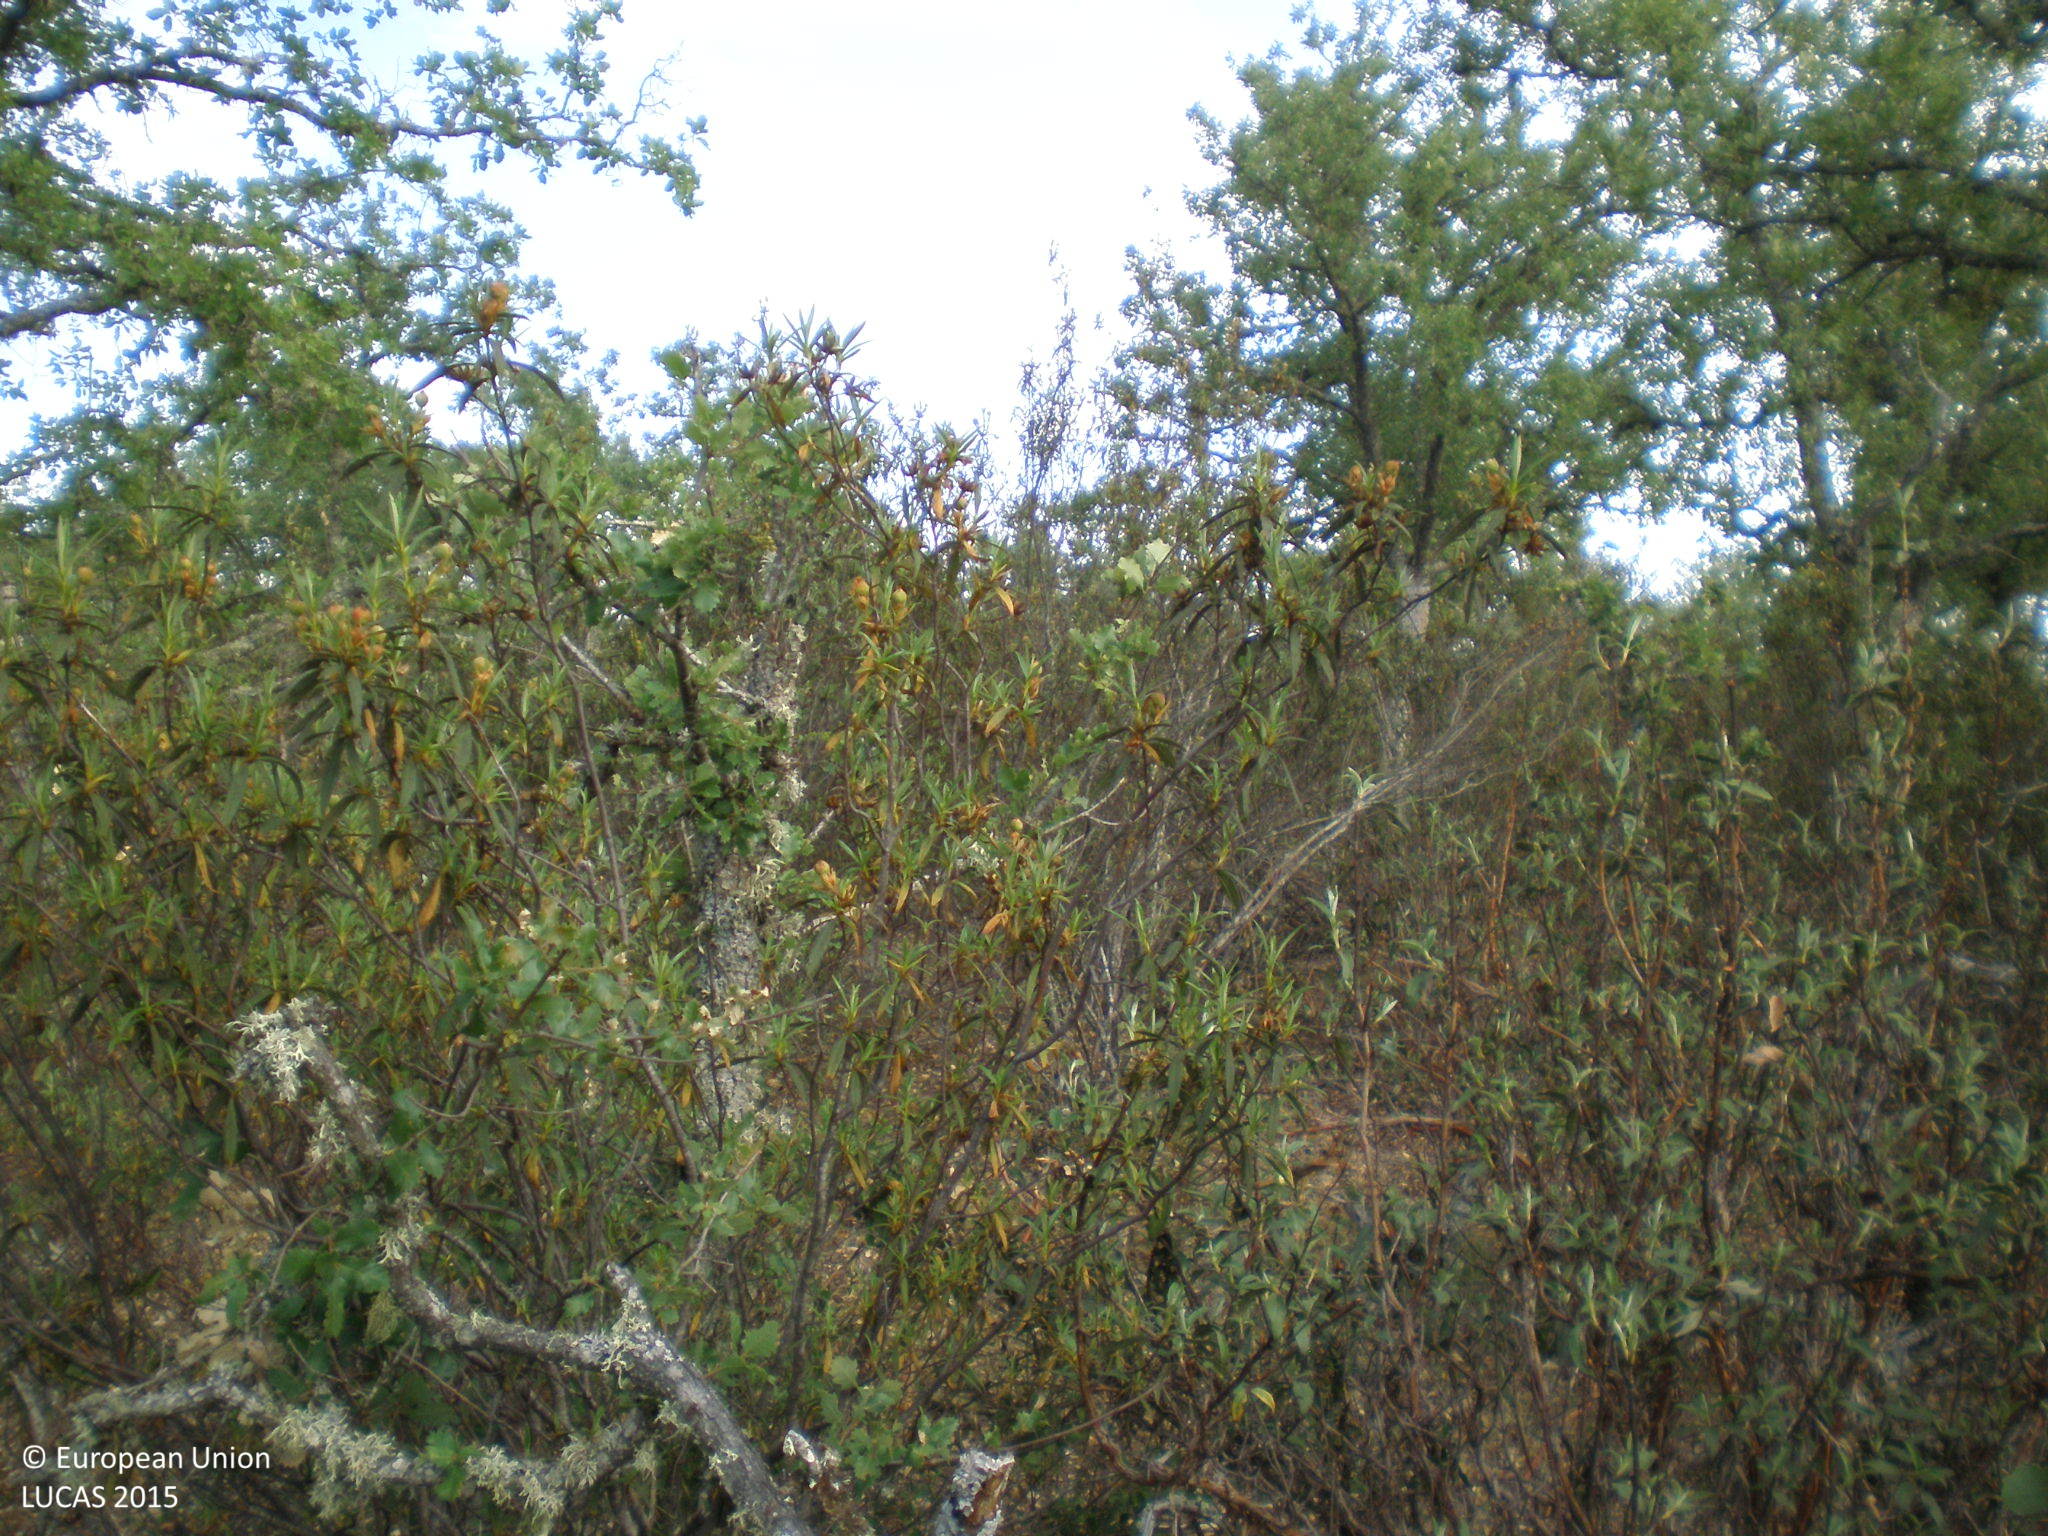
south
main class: Woodland
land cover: Broadleaved woodland
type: broadleaved evergreen forest
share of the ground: > 75 %
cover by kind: broadleaved forest trees 90 %, herbaceous plants 10 %
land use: Forestry
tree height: > 5 m
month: June
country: ES
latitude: 41.2296
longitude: -5.7467
